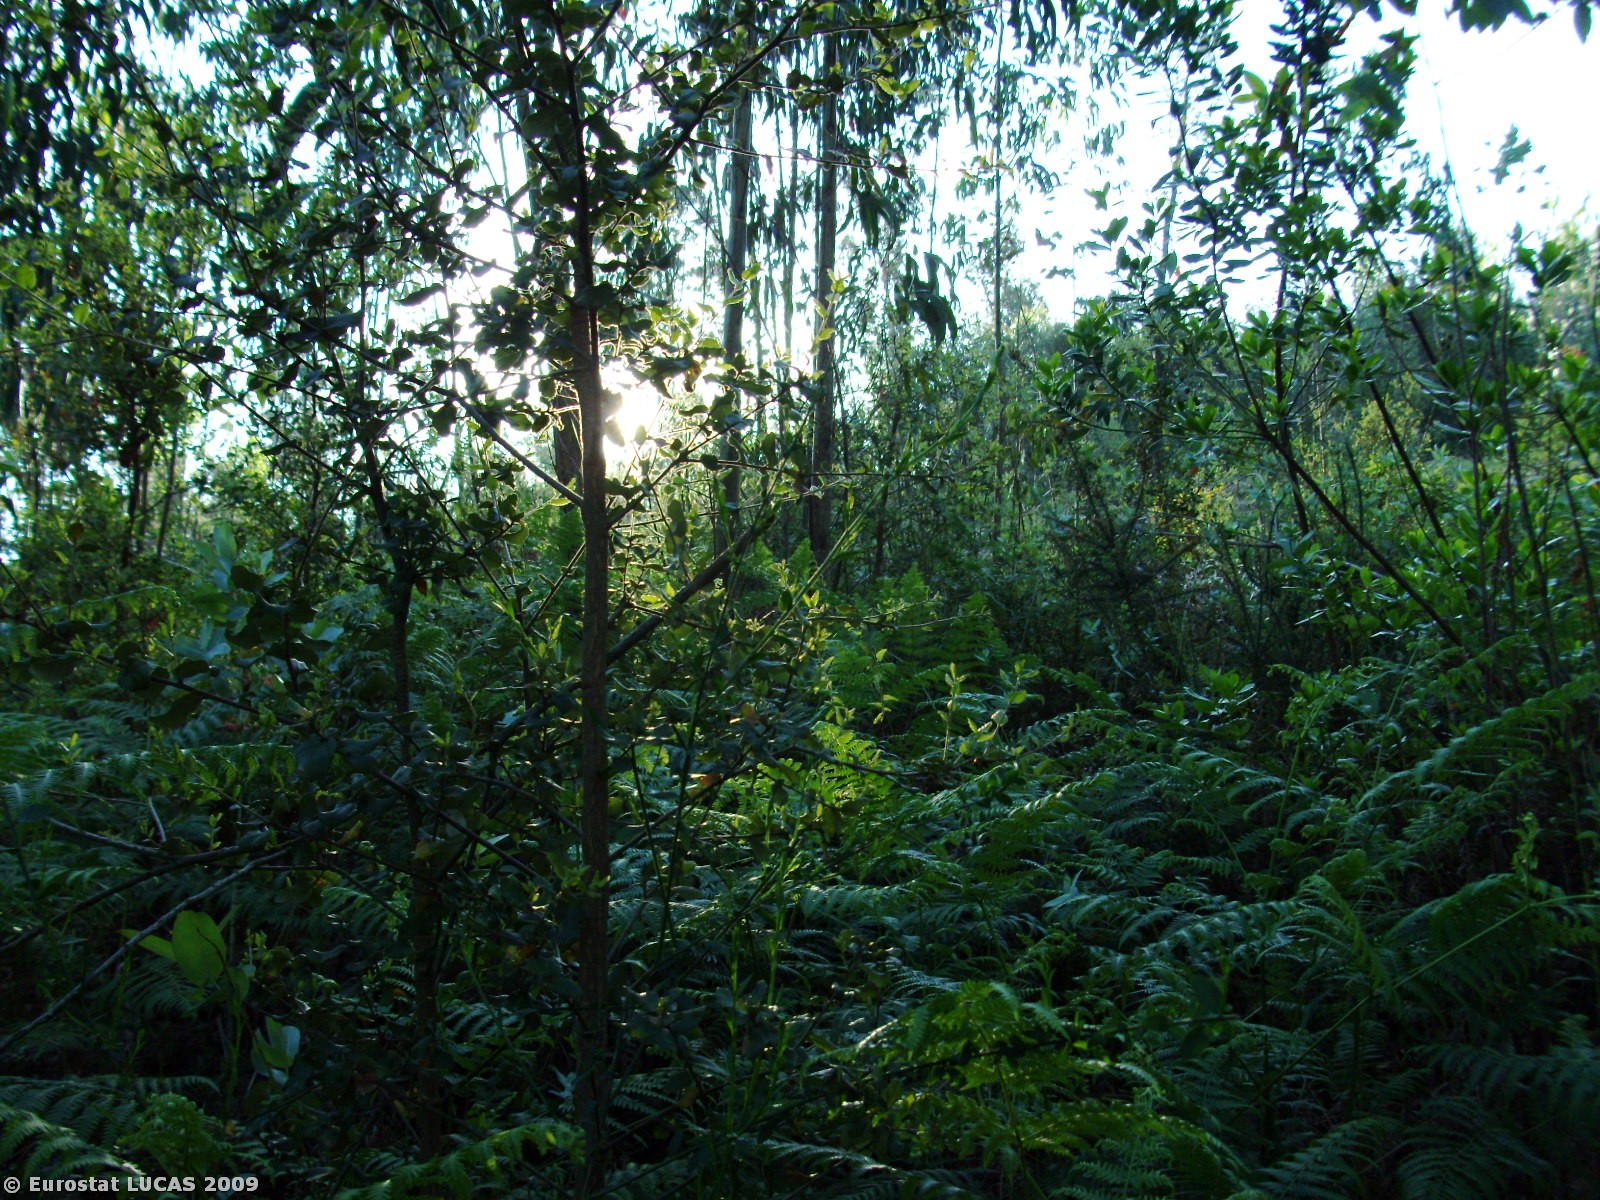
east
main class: Woodland
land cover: Broadleaved woodland
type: plantations and self-sown exotic forest
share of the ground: 50 - 75 %
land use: Forestry
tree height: > 5 m
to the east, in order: Broadleaved woodland; Shrubland with sparse tree cover; Electric lines; Shrubland with sparse tree cover; Broadleaved woodland; Tracks; Broadleaved woodland; Dry stone walls; Broadleaved woodland; Tracks; Broadleaved woodland; Tracks; Broadleaved woodland
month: May
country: PT
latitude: 40.8282
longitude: -8.4629
